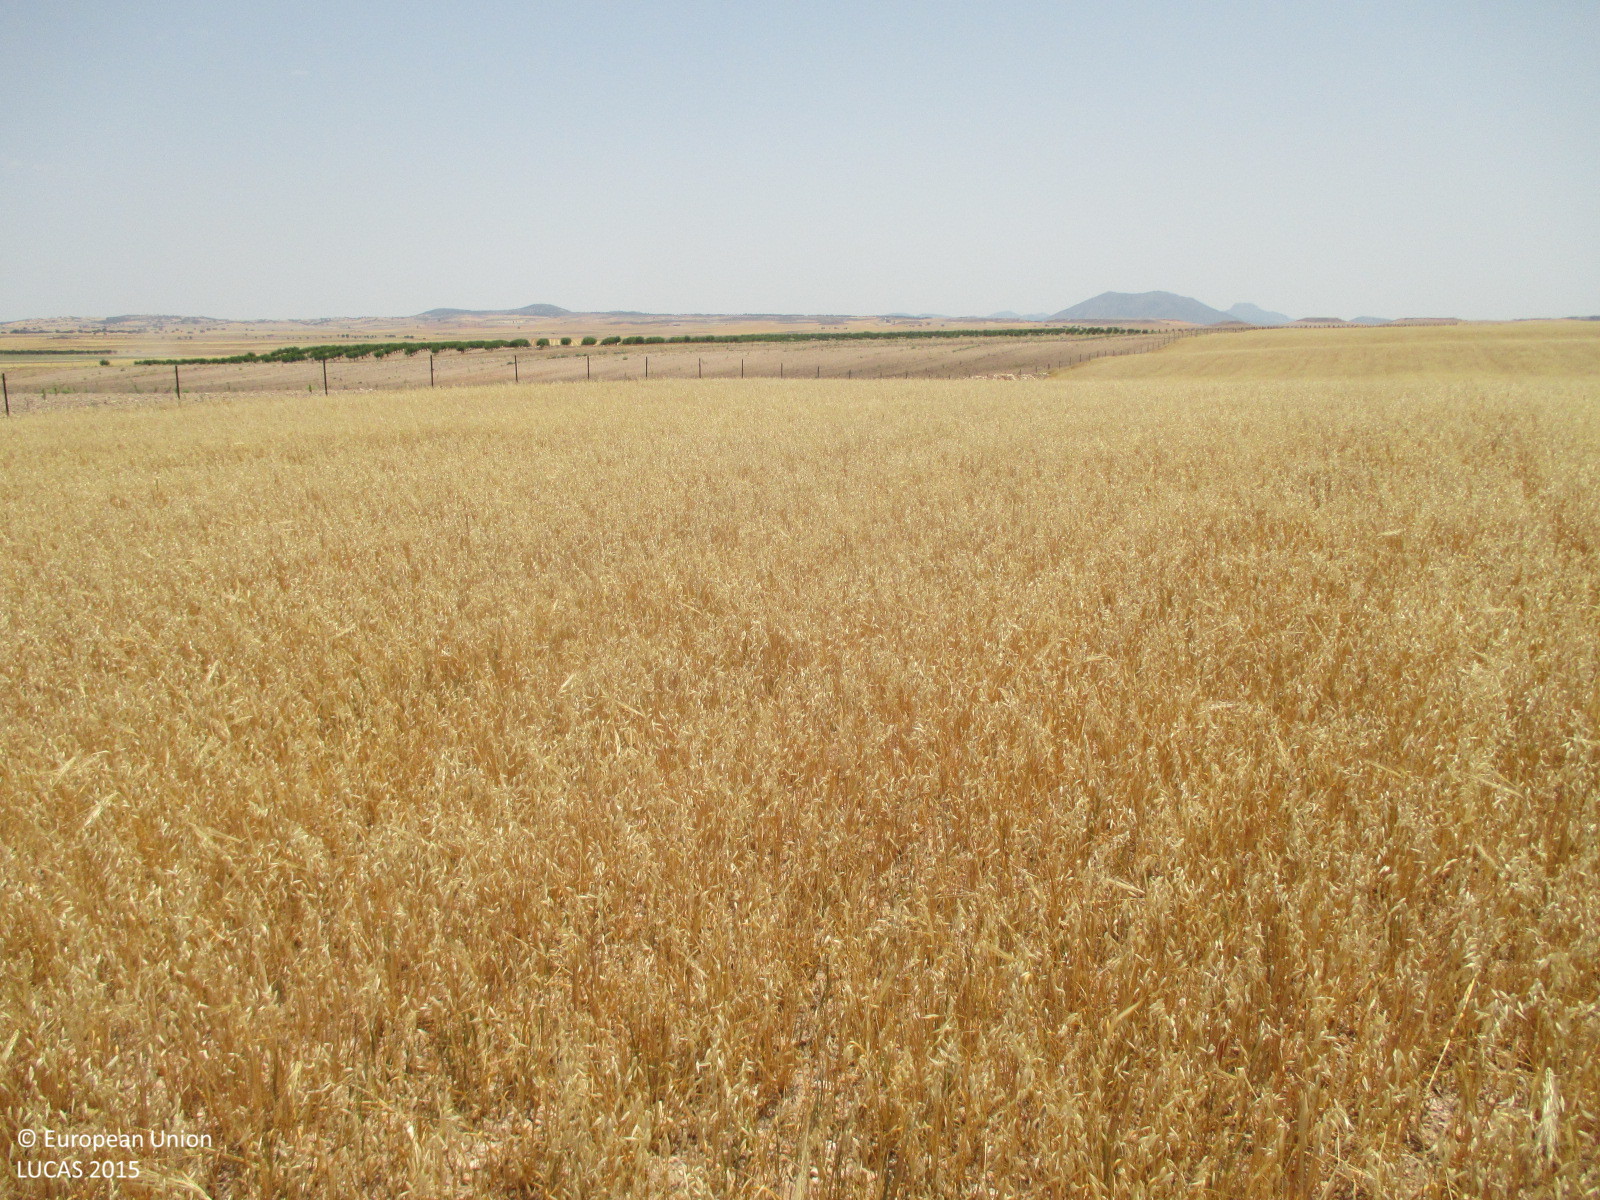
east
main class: Cropland
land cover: Oats
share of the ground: > 75 %
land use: Agriculture (excluding fallow land and kitchen gardens)
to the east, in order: Oats; Fences; Nuts trees
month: July
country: ES
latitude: 37.8261
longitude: -2.2925
